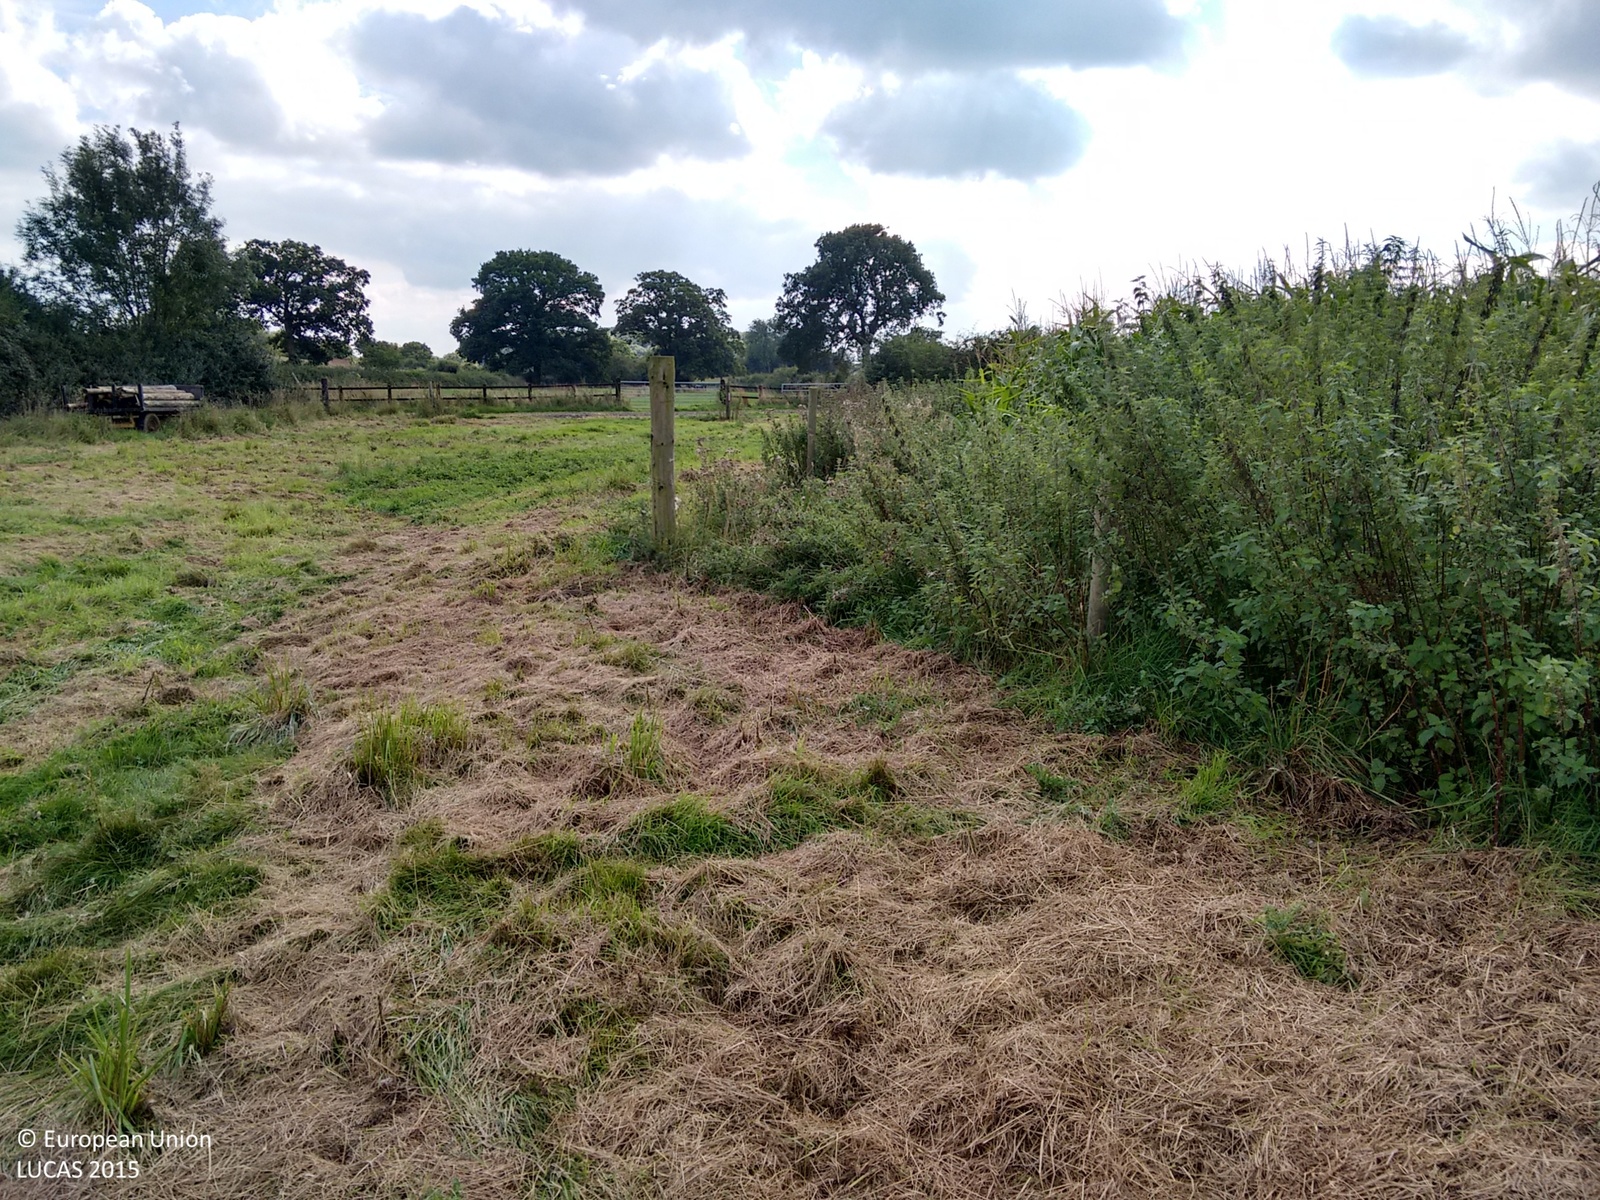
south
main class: Grassland
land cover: Grassland without tree/shrub cover
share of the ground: > 75 %
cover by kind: herbaceous plants 100 %
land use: Agriculture (excluding fallow land and kitchen gardens)
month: September
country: GB
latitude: 52.5298
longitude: 1.3268
